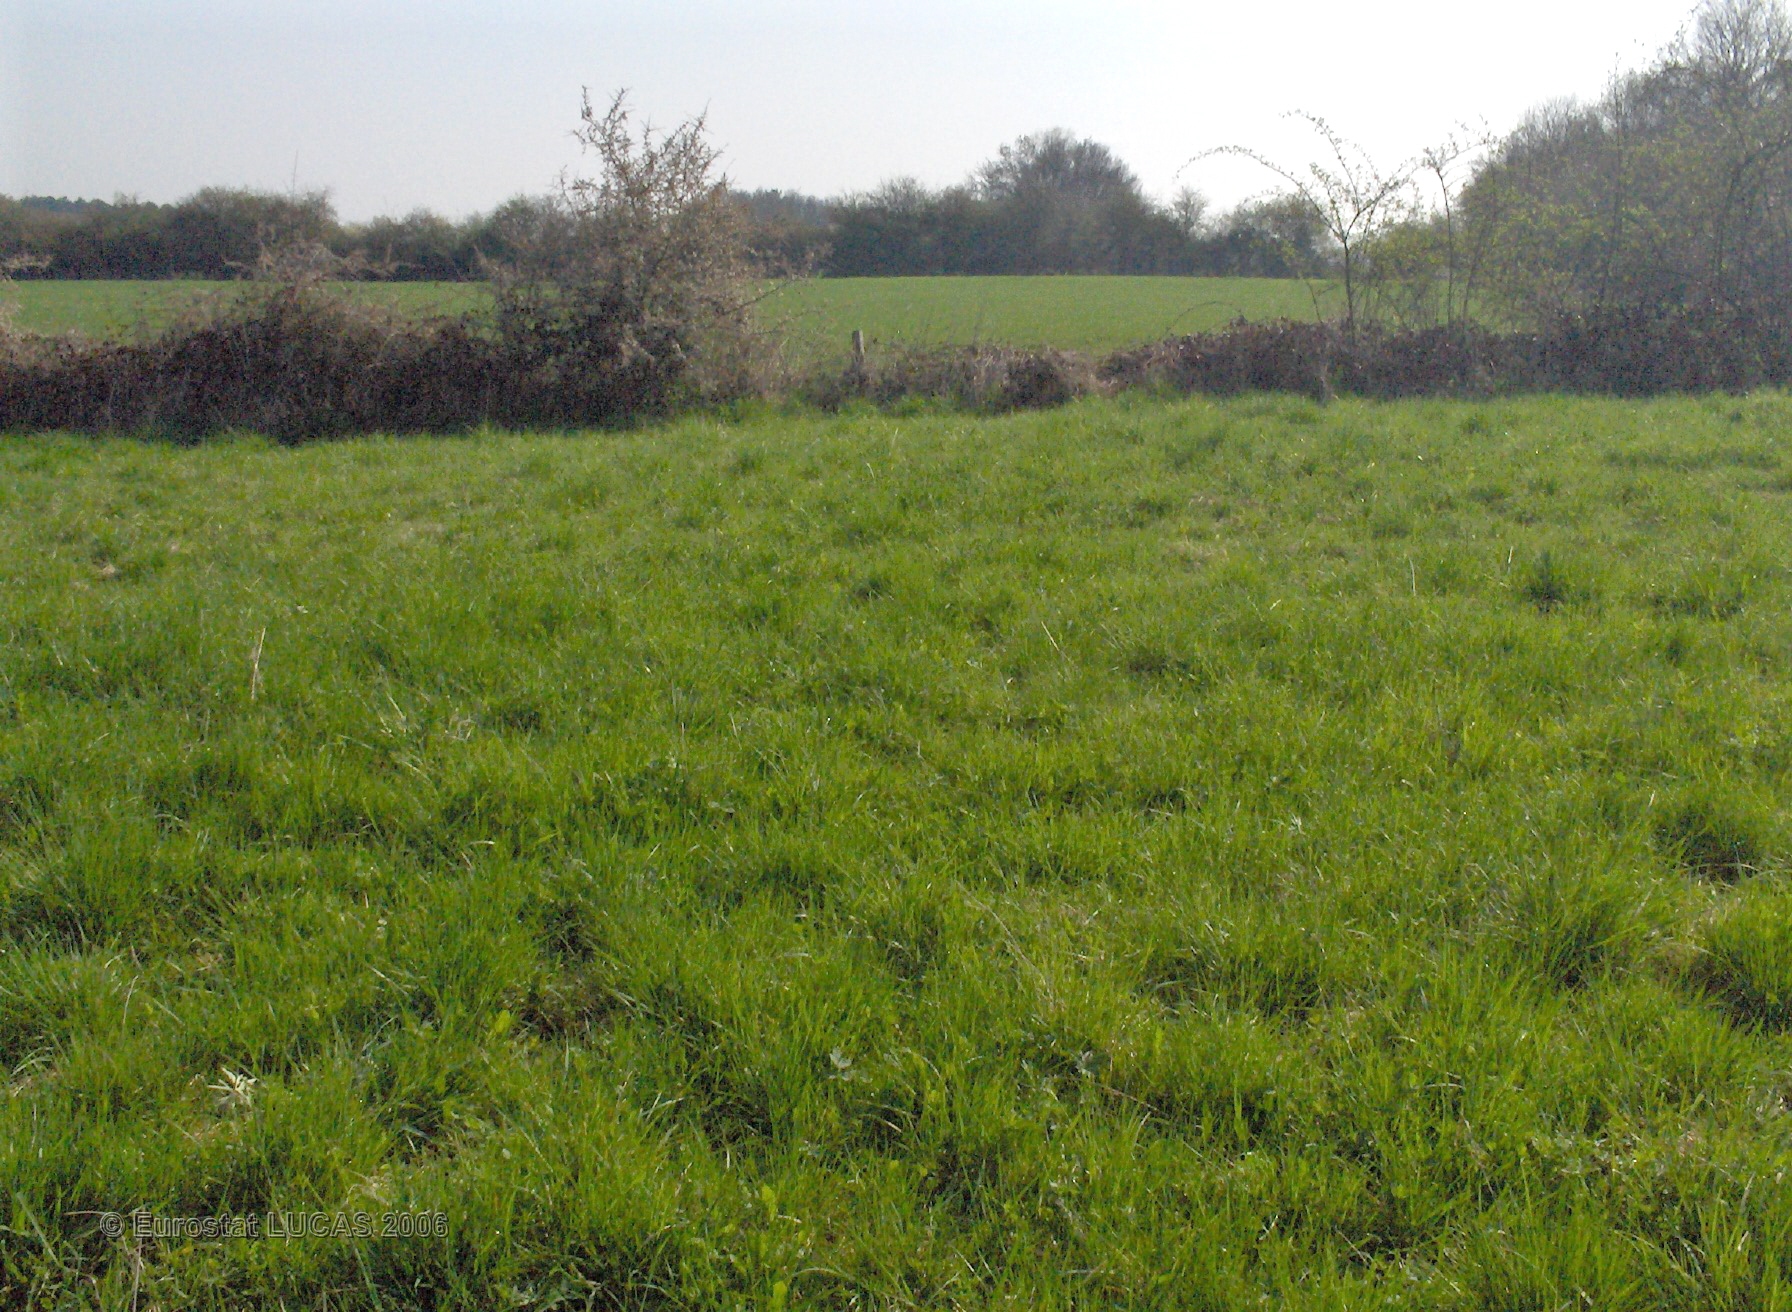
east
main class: Grassland
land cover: Grassland without tree/shrub cover
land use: Agriculture (excluding fallow land and kitchen gardens)
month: April
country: BE
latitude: 50.0725
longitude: 4.5610
